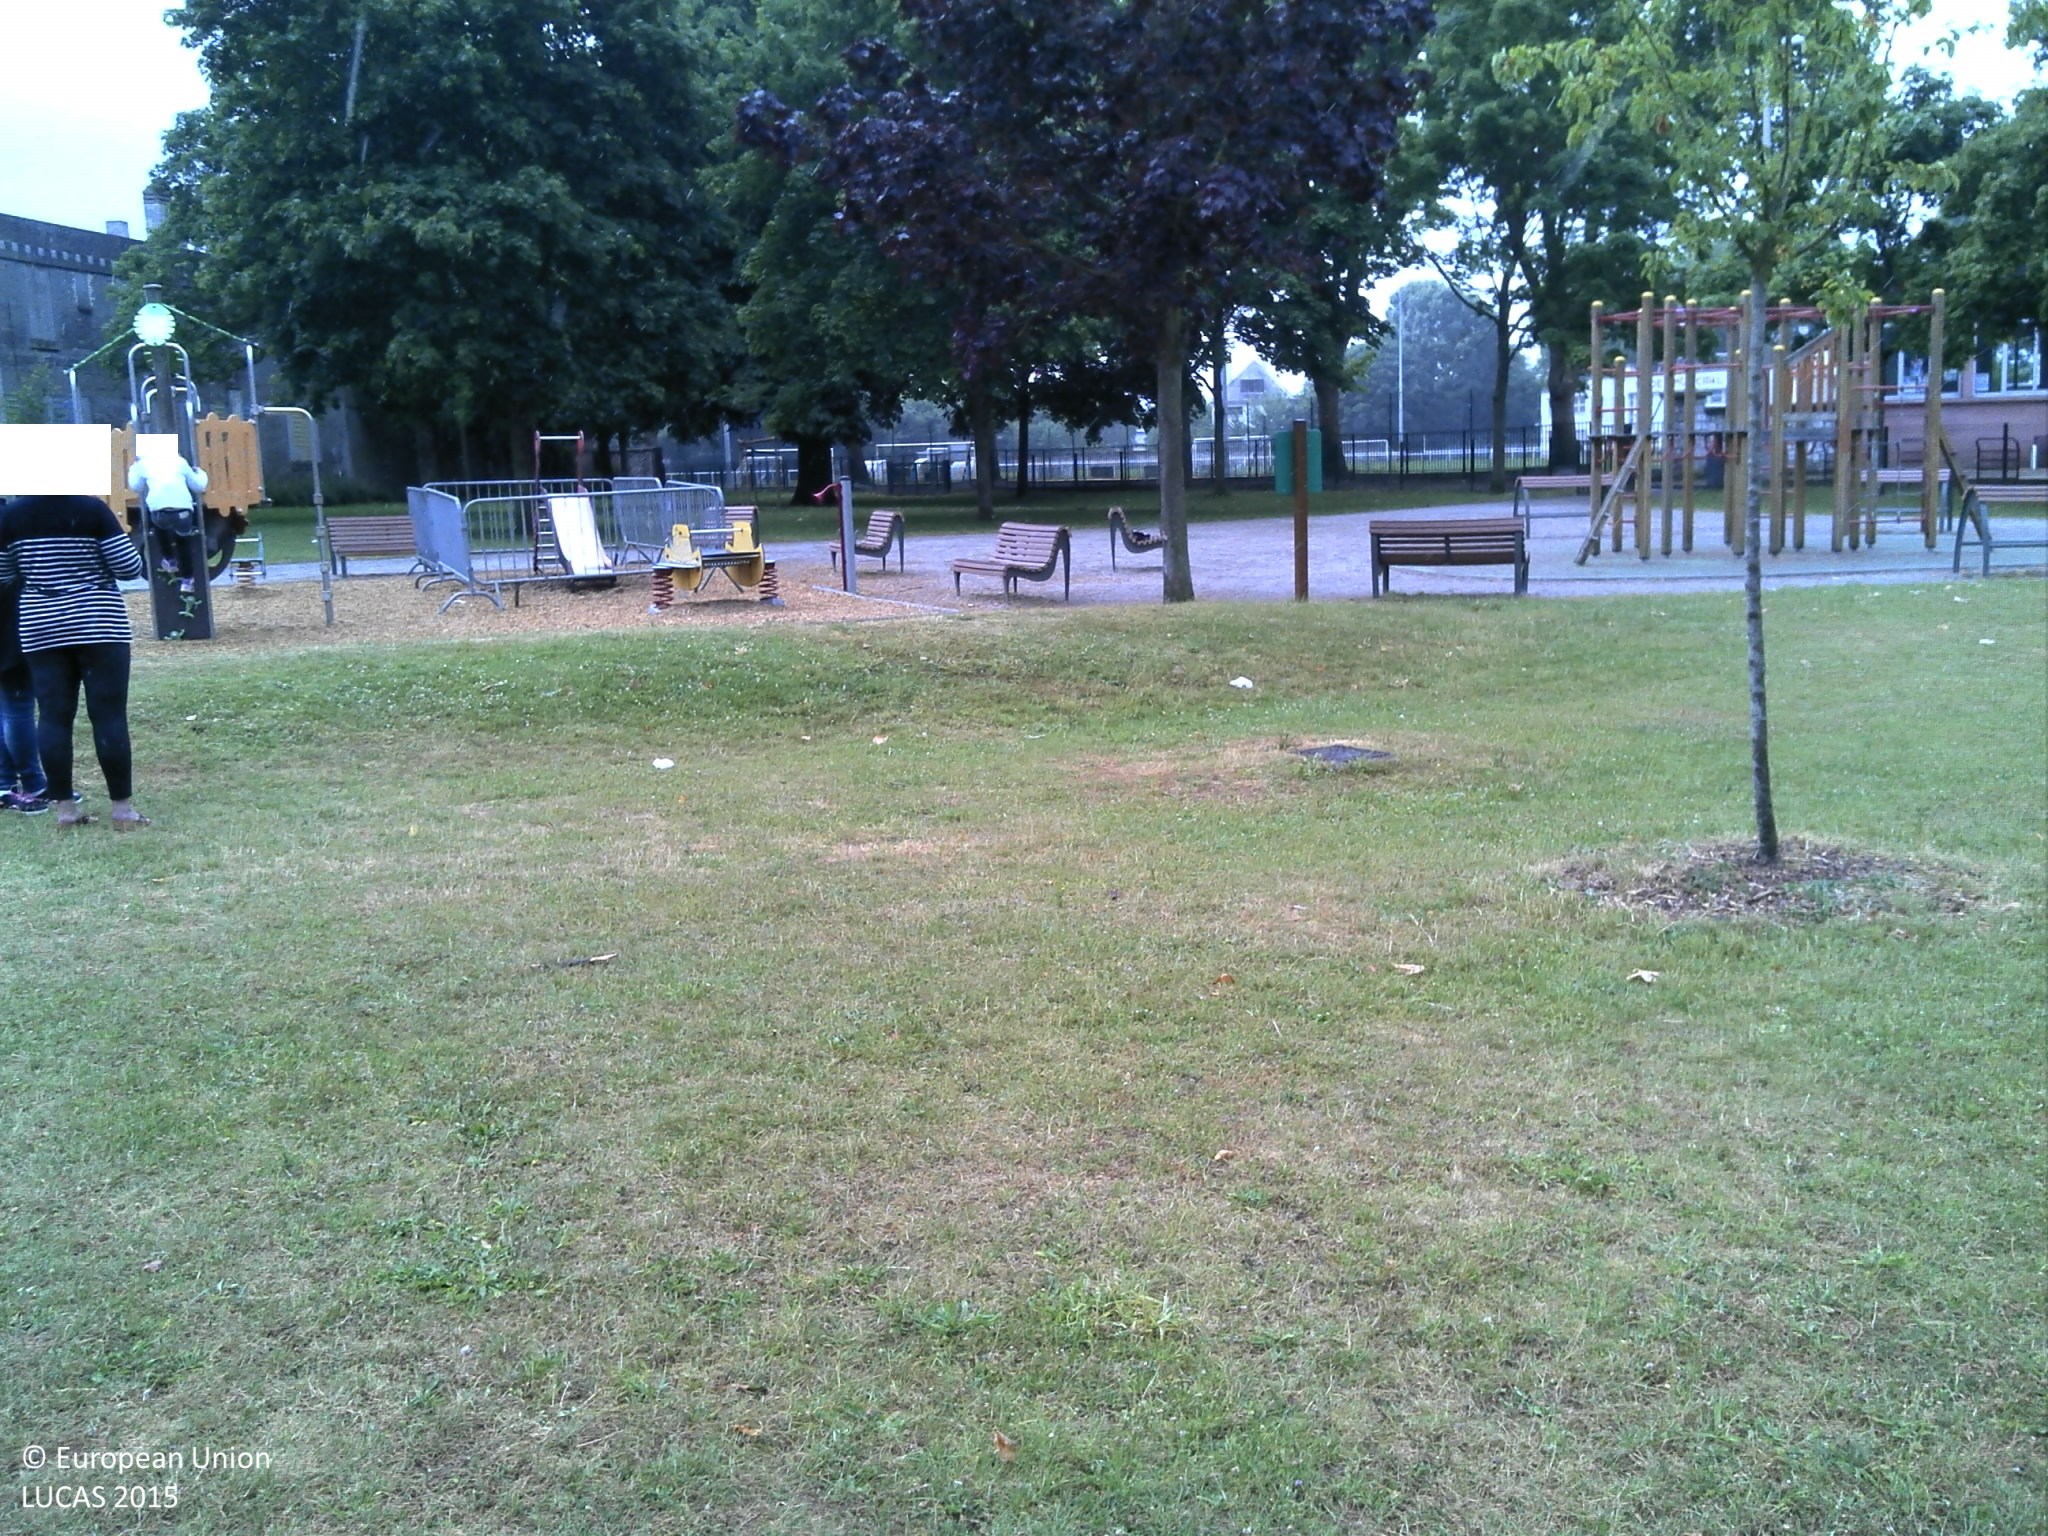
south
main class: Grassland
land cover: Grassland with sparse tree/shrub cover
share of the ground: > 75 %
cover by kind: herbaceous plants 95 %, broadleaved forest trees 5 %
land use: Amenities, museums, leisure
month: June
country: FR
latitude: 49.4141
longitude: 1.0324
